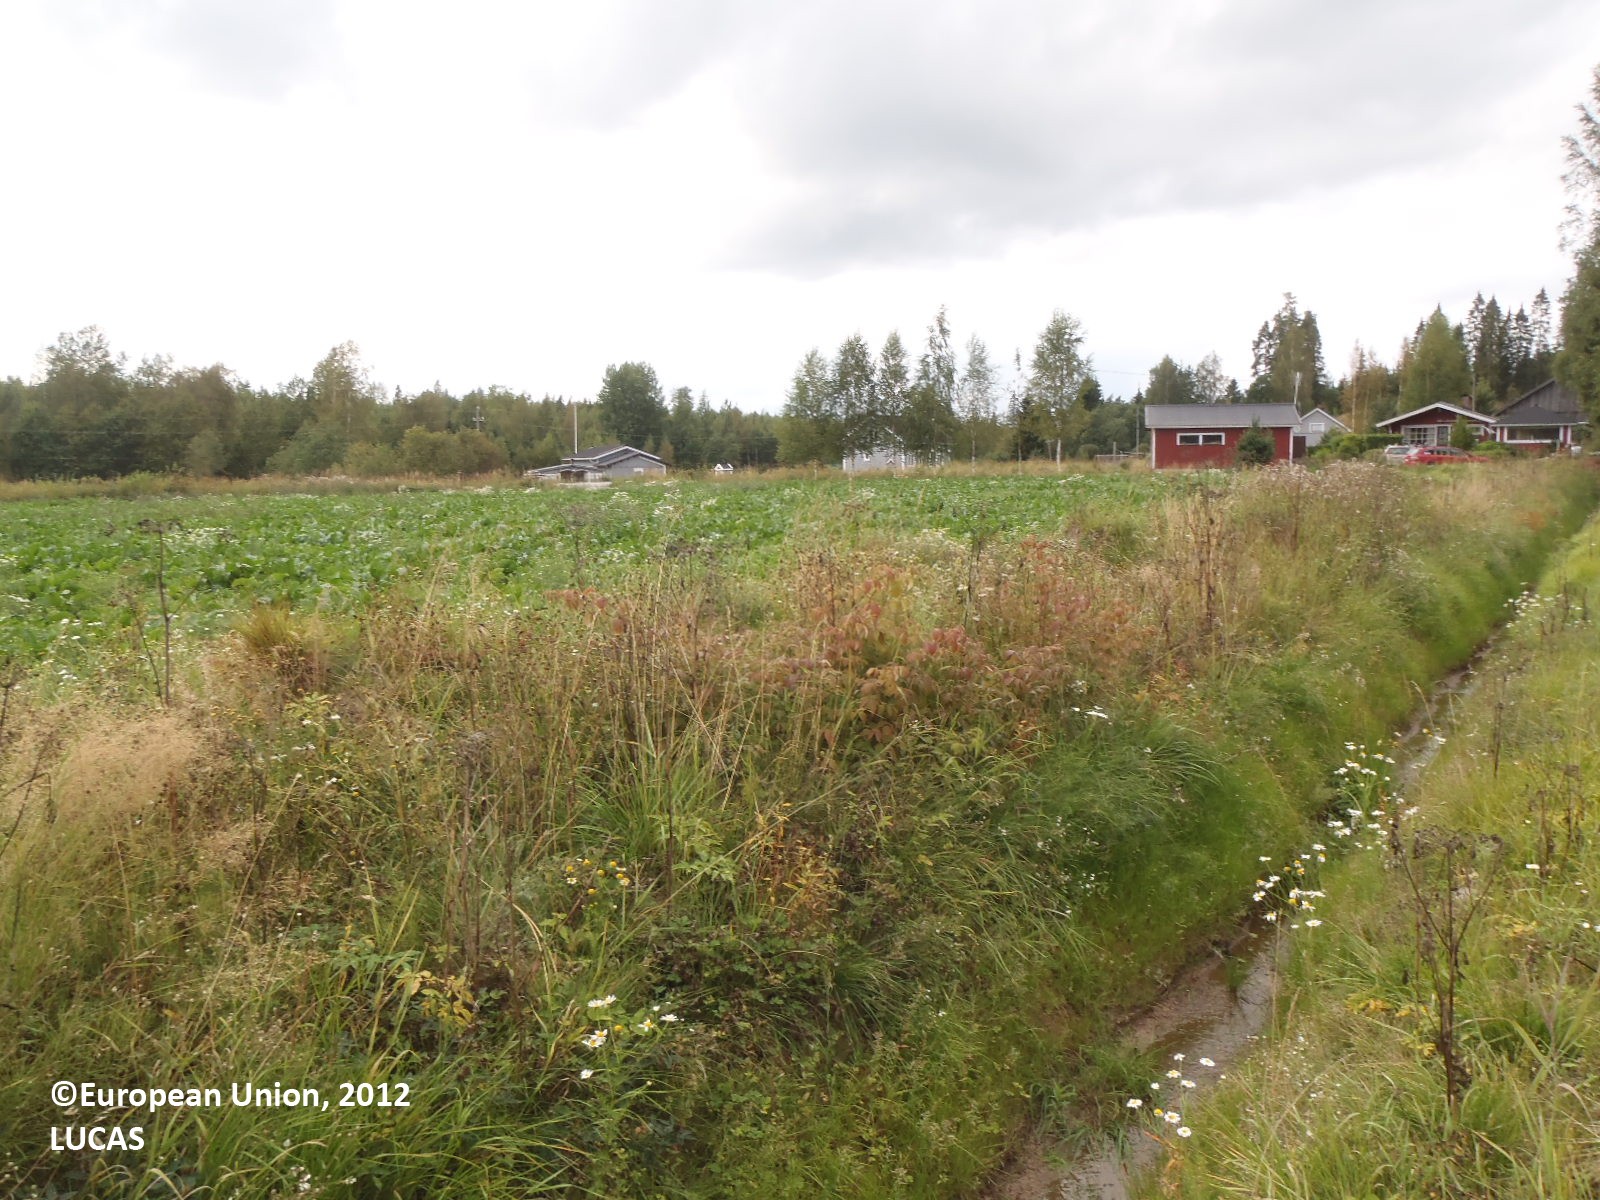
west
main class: Cropland
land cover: Barley
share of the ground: > 75 %
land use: Agriculture (excluding fallow land and kitchen gardens)
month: August
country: FI
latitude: 60.9944
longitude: 22.4717
